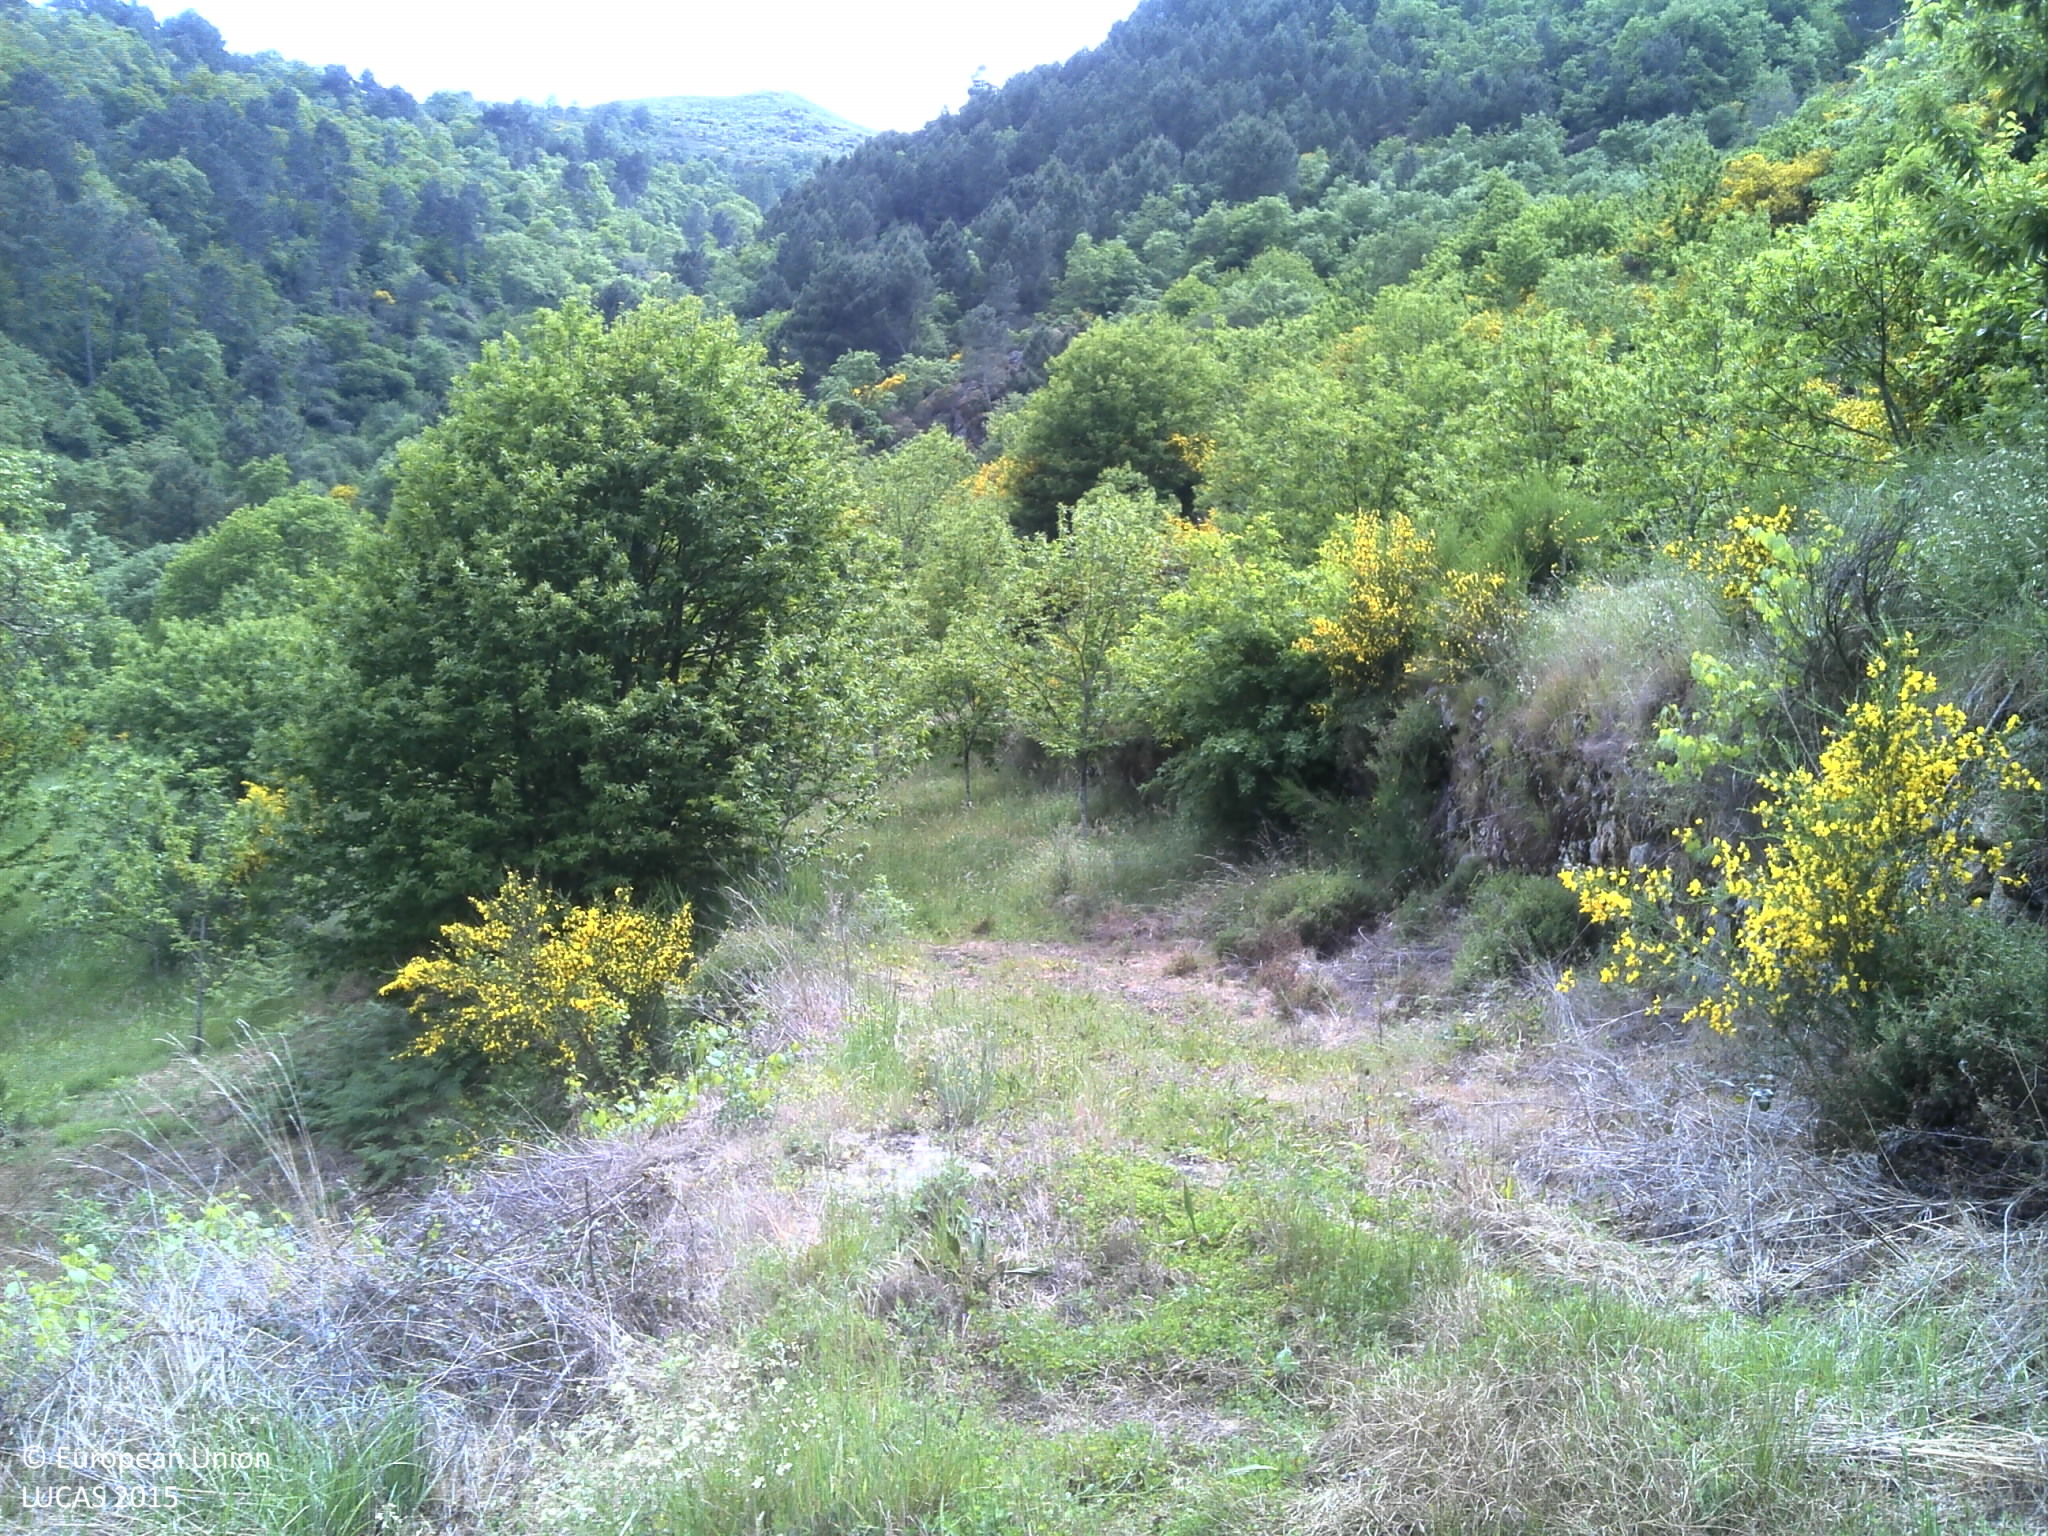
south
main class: Shrubland
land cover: Shrubland with sparse tree cover
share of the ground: 50 - 75 %
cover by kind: shrubs 75 %, herbaceous plants 15 %, broadleaved forest trees 5 %, unconsolidated bare surface 5 %
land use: Semi-natural and natural areas not in use
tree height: < 5 m
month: May
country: PT
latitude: 41.0720
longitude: -7.9488
